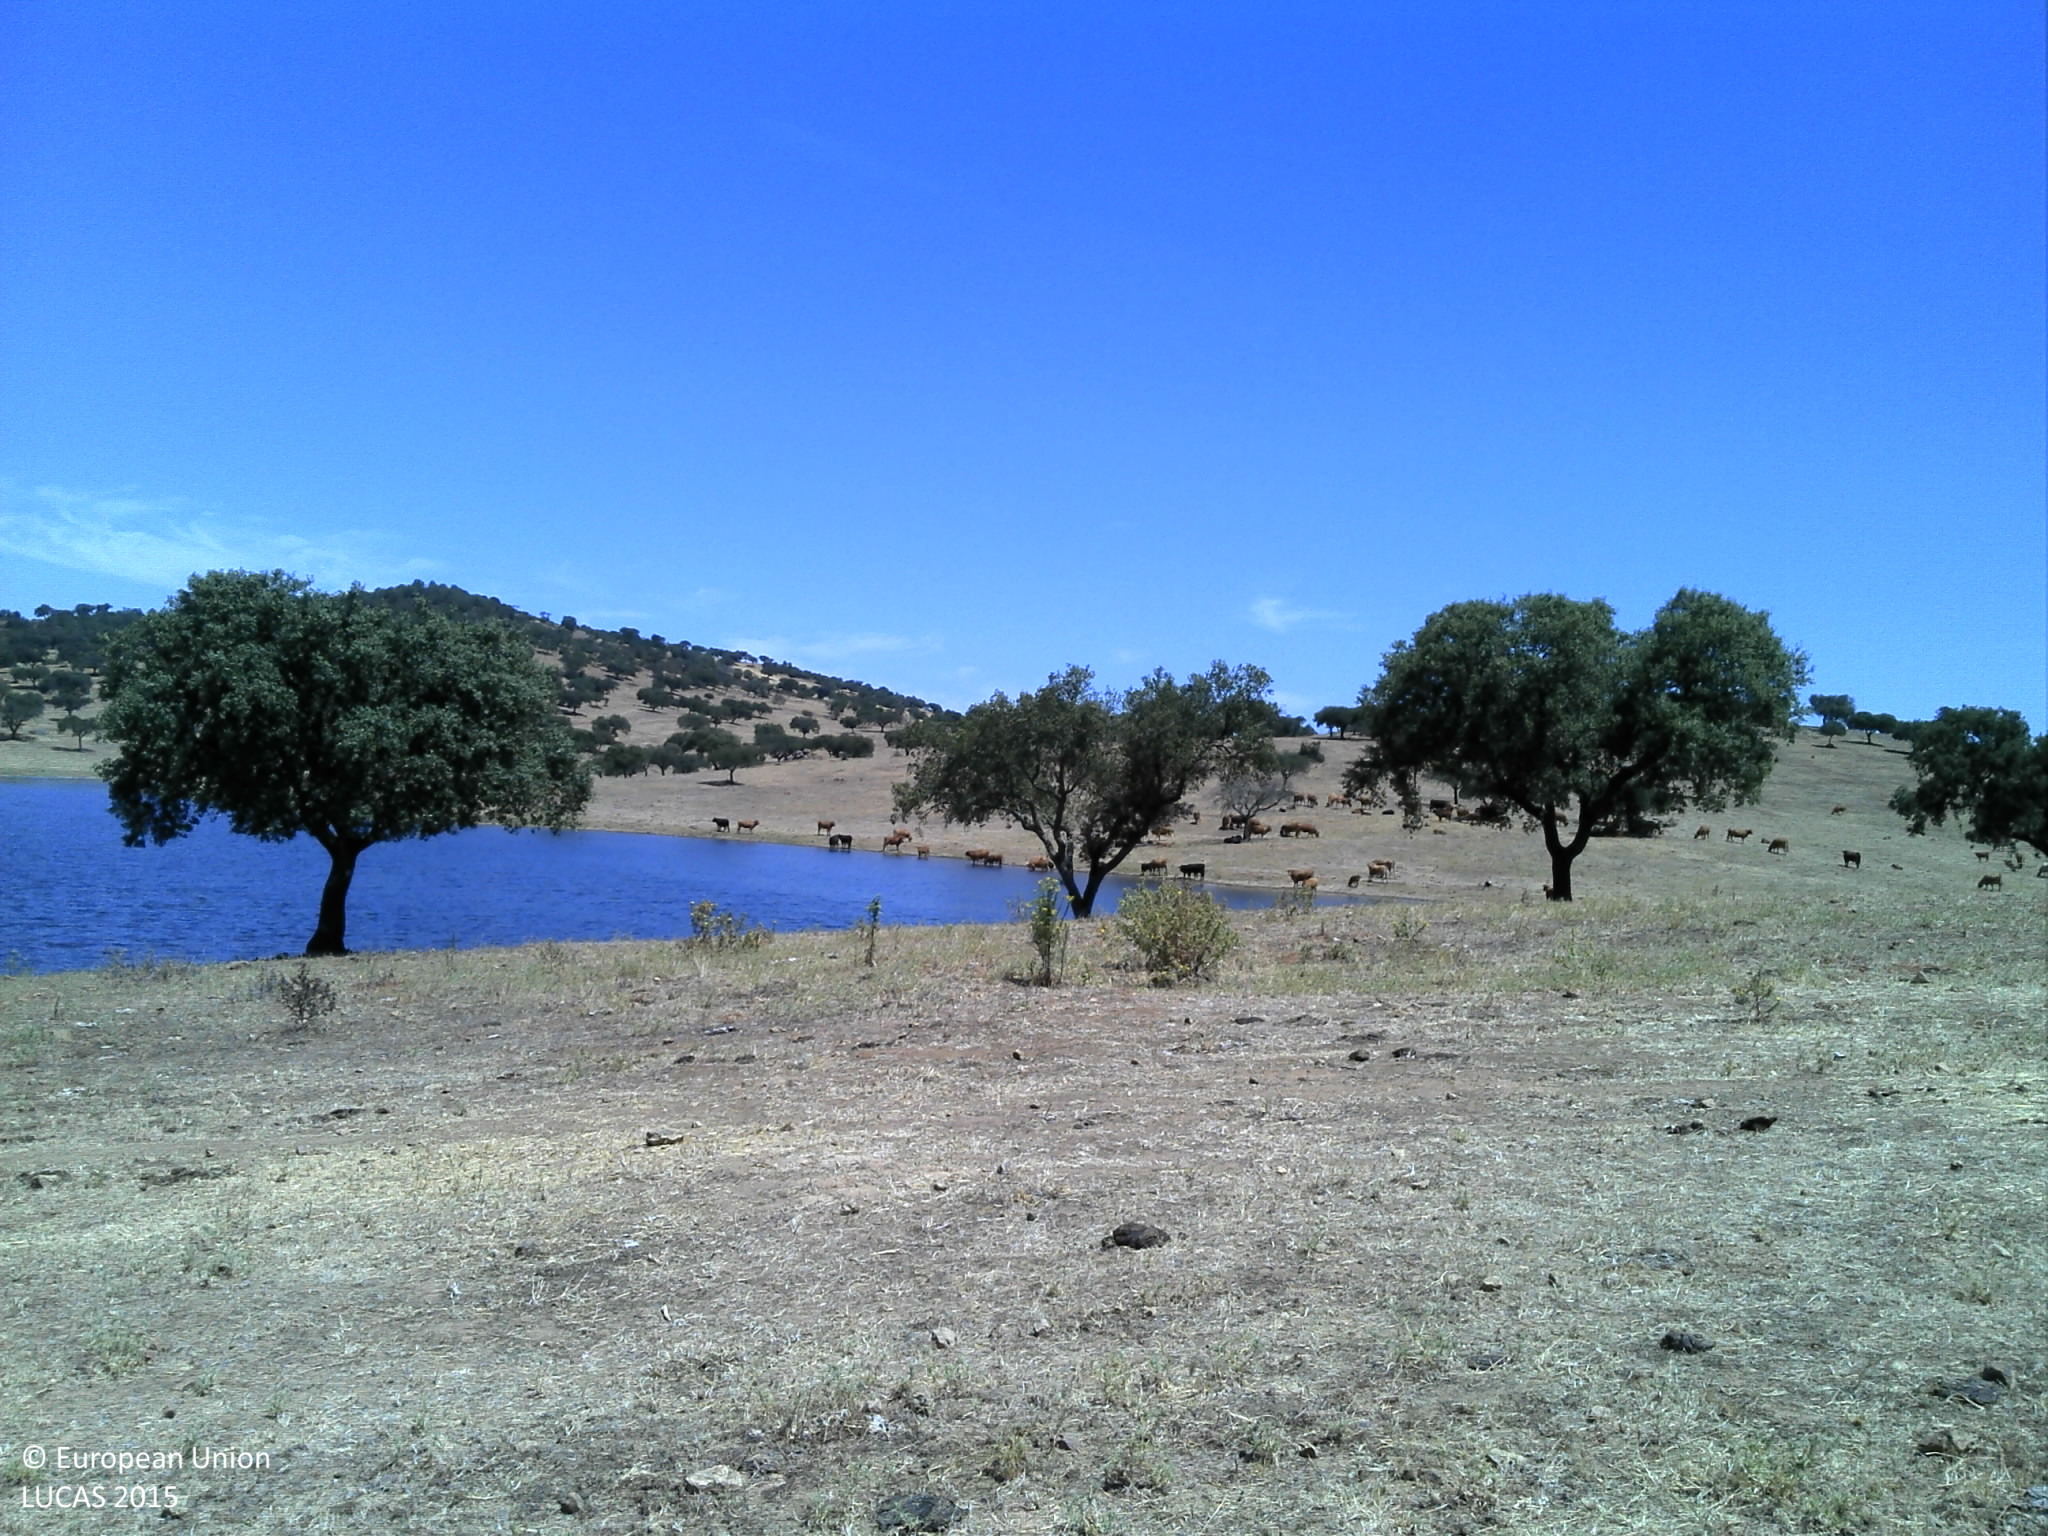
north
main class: Grassland
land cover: Grassland without tree/shrub cover
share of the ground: < 10 %
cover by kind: unconsolidated bare surface 90 %, herbaceous plants 10 %
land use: Agriculture (excluding fallow land and kitchen gardens)
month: June
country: PT
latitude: 38.2659
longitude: -8.1318
